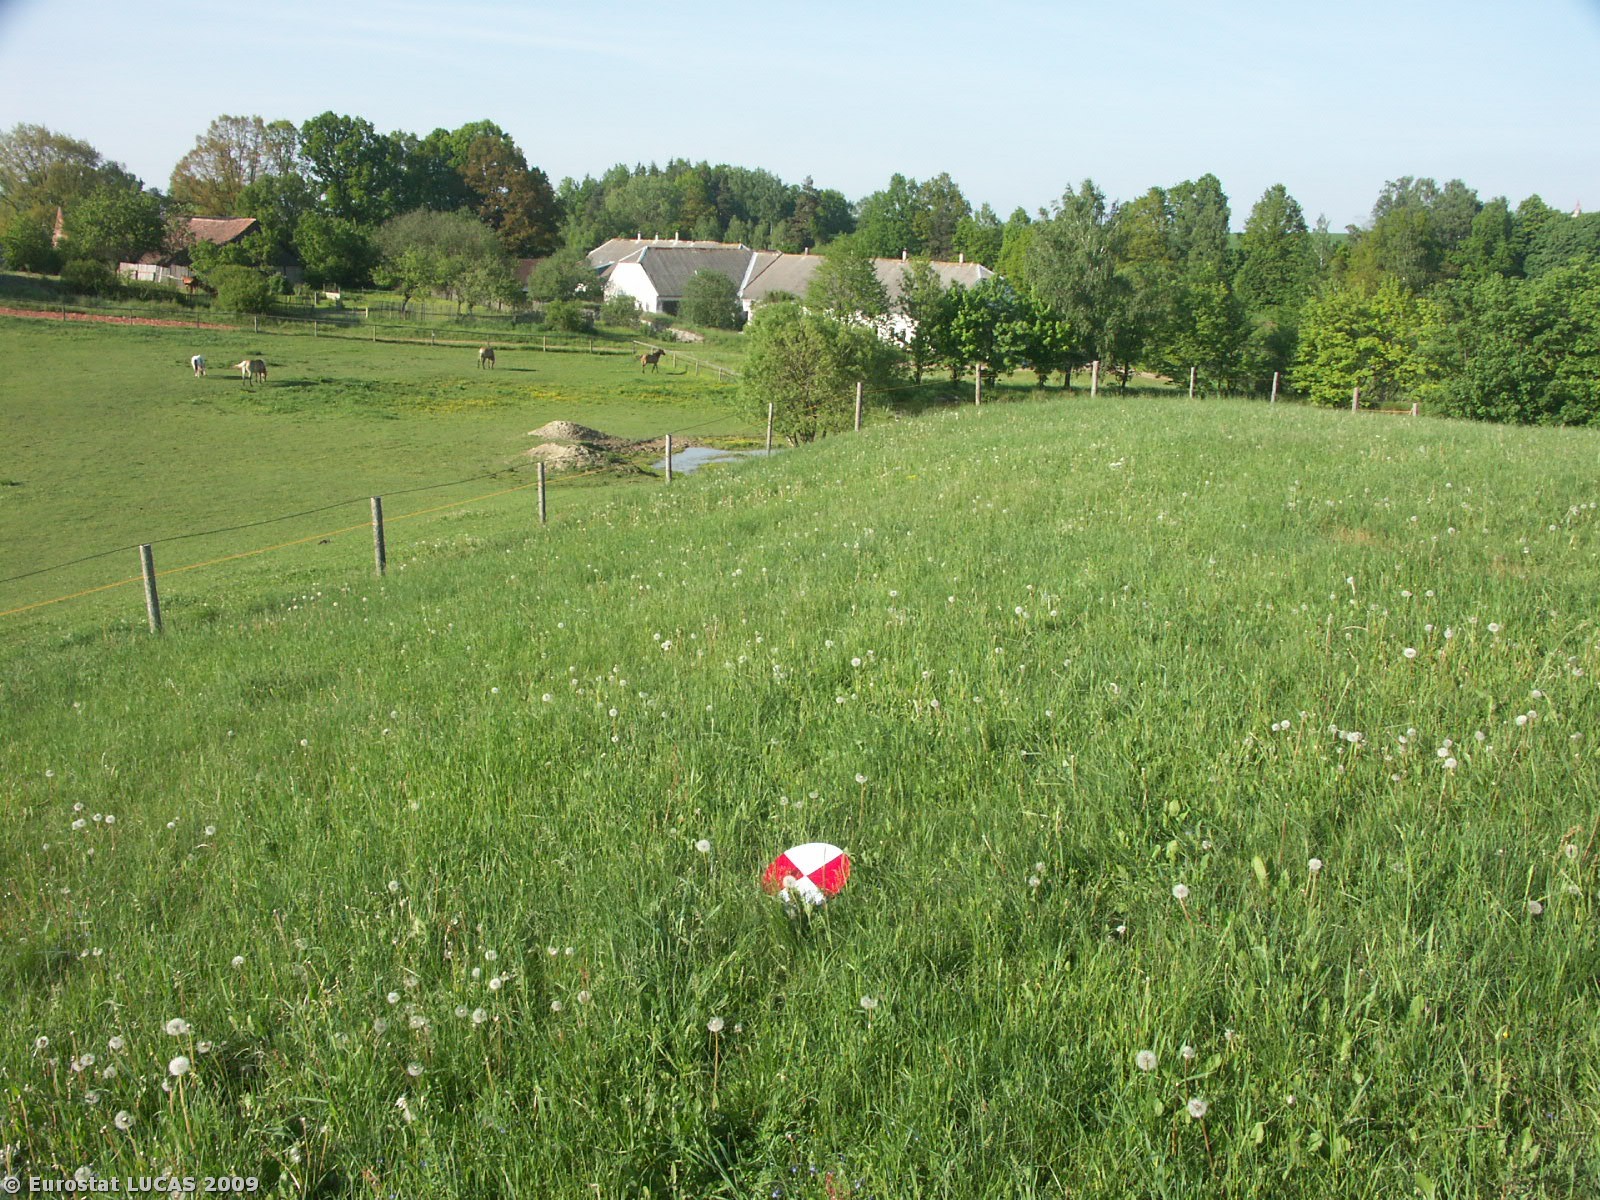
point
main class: Grassland
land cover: Grassland without tree/shrub cover
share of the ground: > 75 %
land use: Agriculture (excluding fallow land and kitchen gardens)
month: May
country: CZ
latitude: 49.0120
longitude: 15.3762
